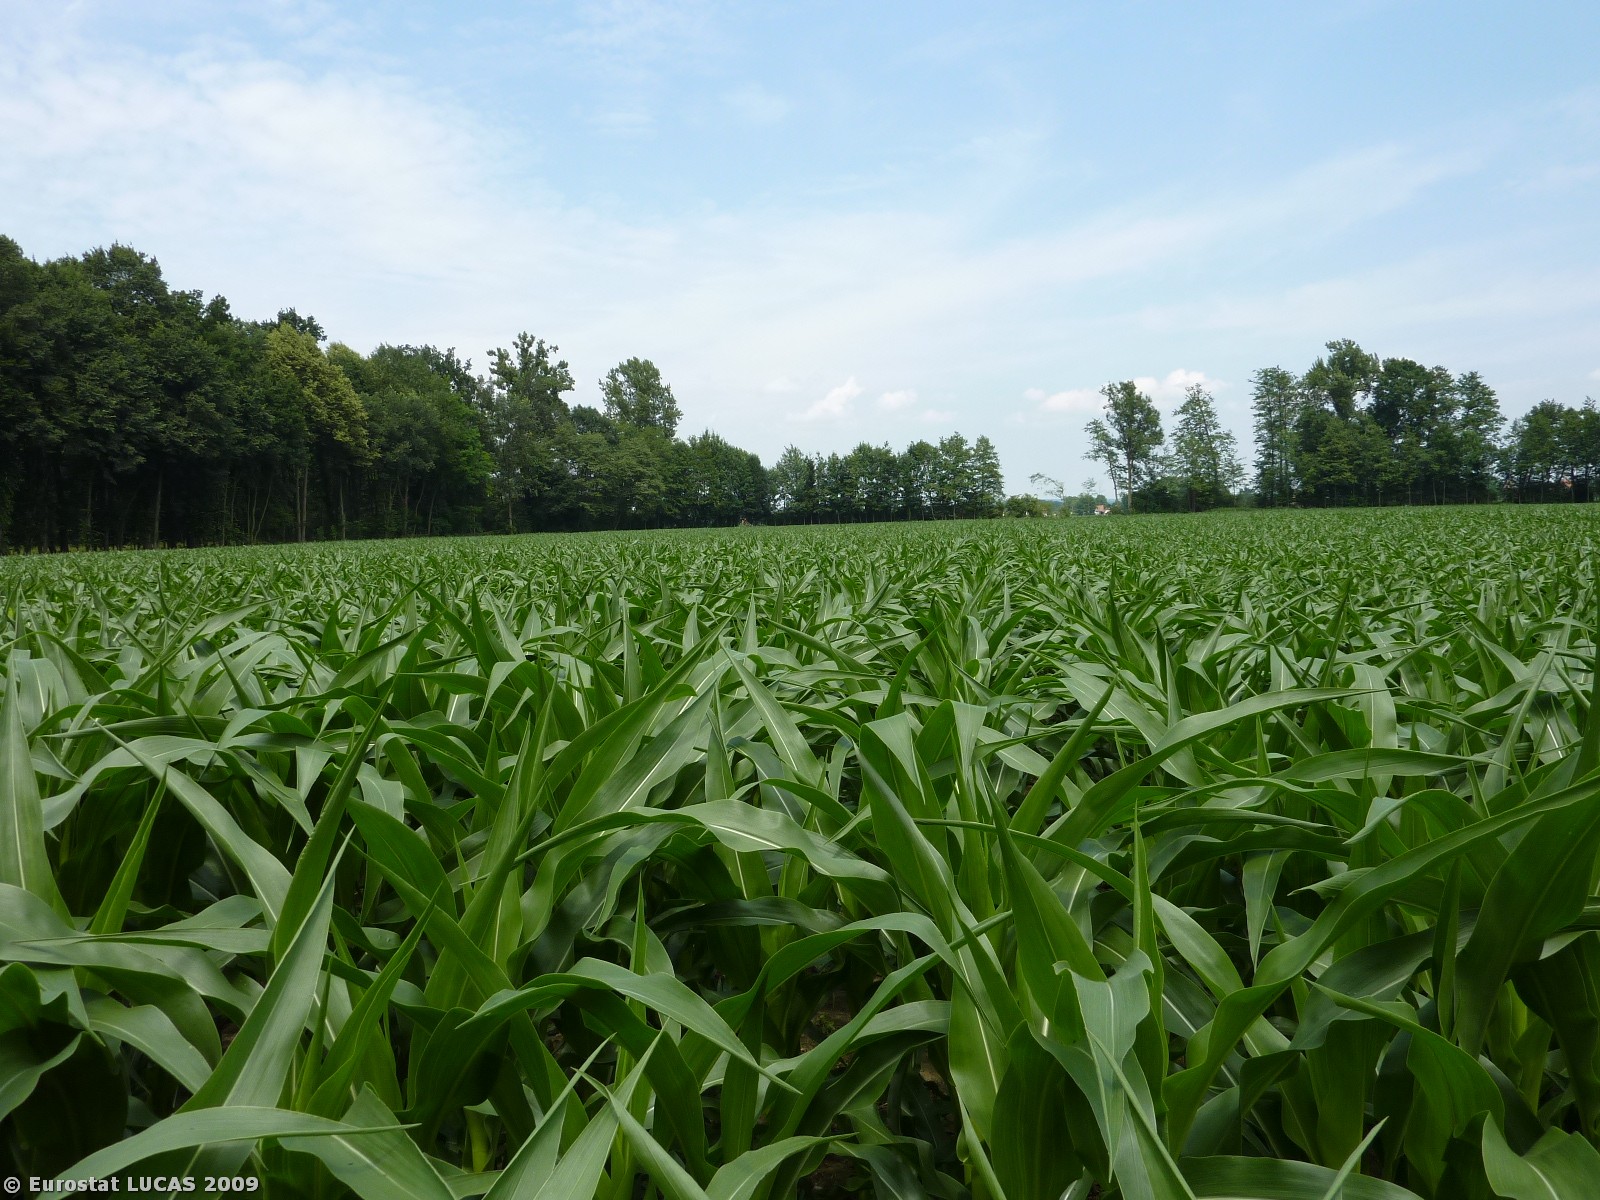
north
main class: Cropland
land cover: Maize
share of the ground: > 75 %
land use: Agriculture (excluding fallow land and kitchen gardens)
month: June
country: AT
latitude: 46.7053
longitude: 15.6891
